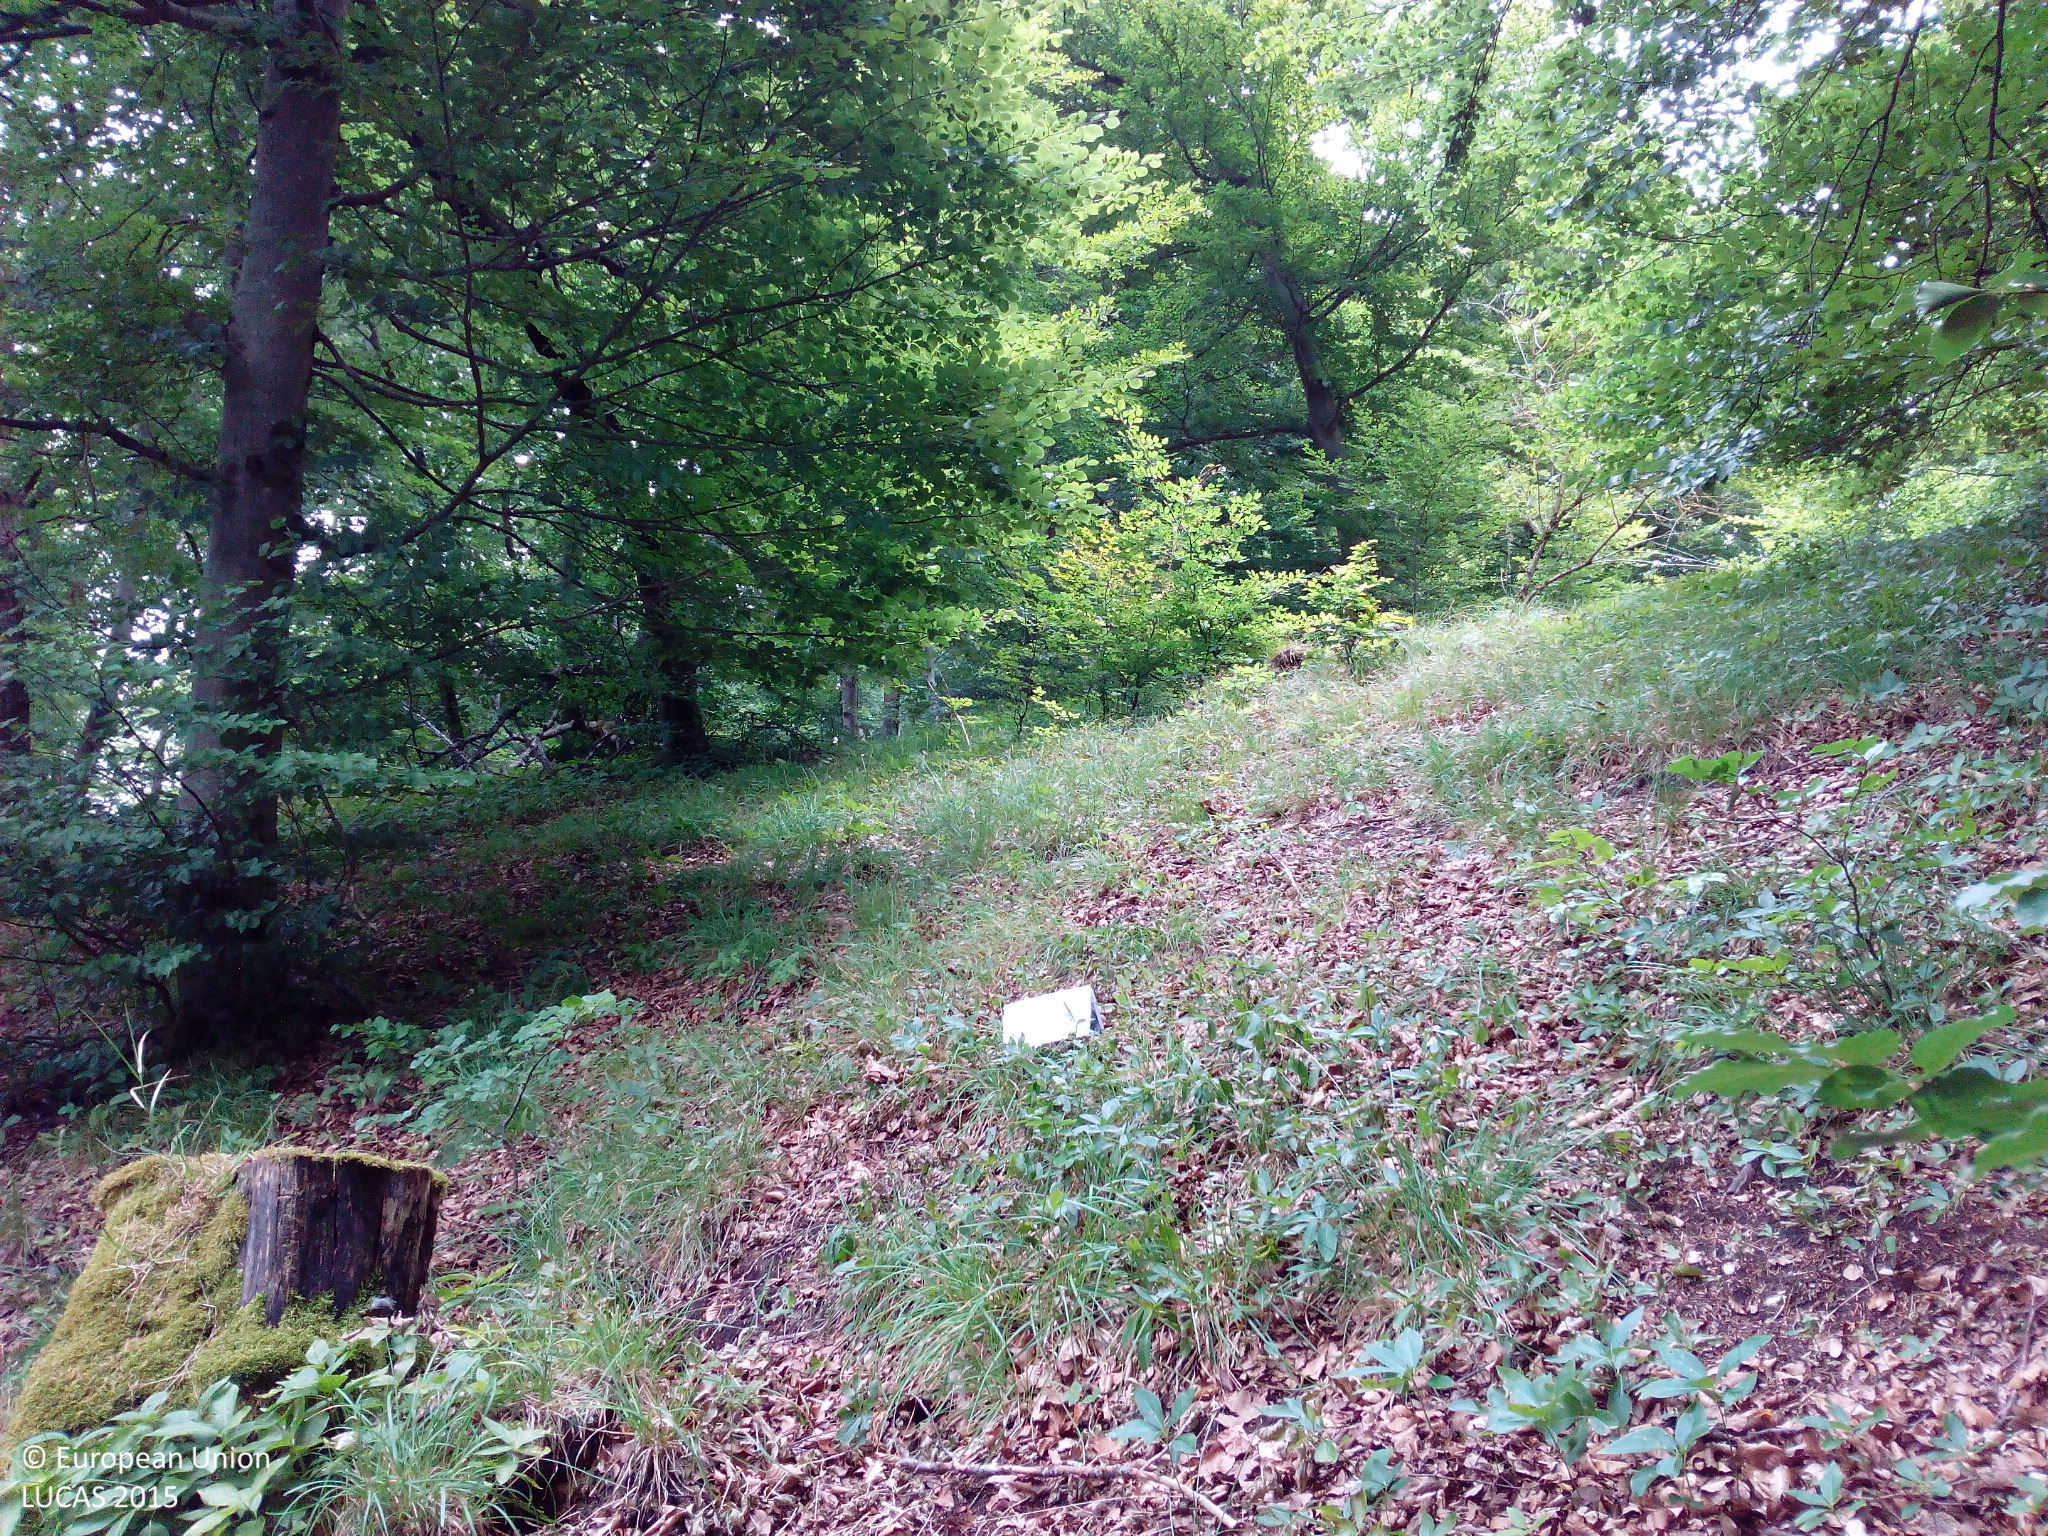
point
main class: Woodland
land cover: Broadleaved woodland
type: beech forest
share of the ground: > 75 %
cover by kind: broadleaved forest trees 75 %, unconsolidated bare surface 15 %, herbaceous plants 10 %
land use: Forestry
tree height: > 5 m
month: July
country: DE
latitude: 48.8528
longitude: 10.3133
